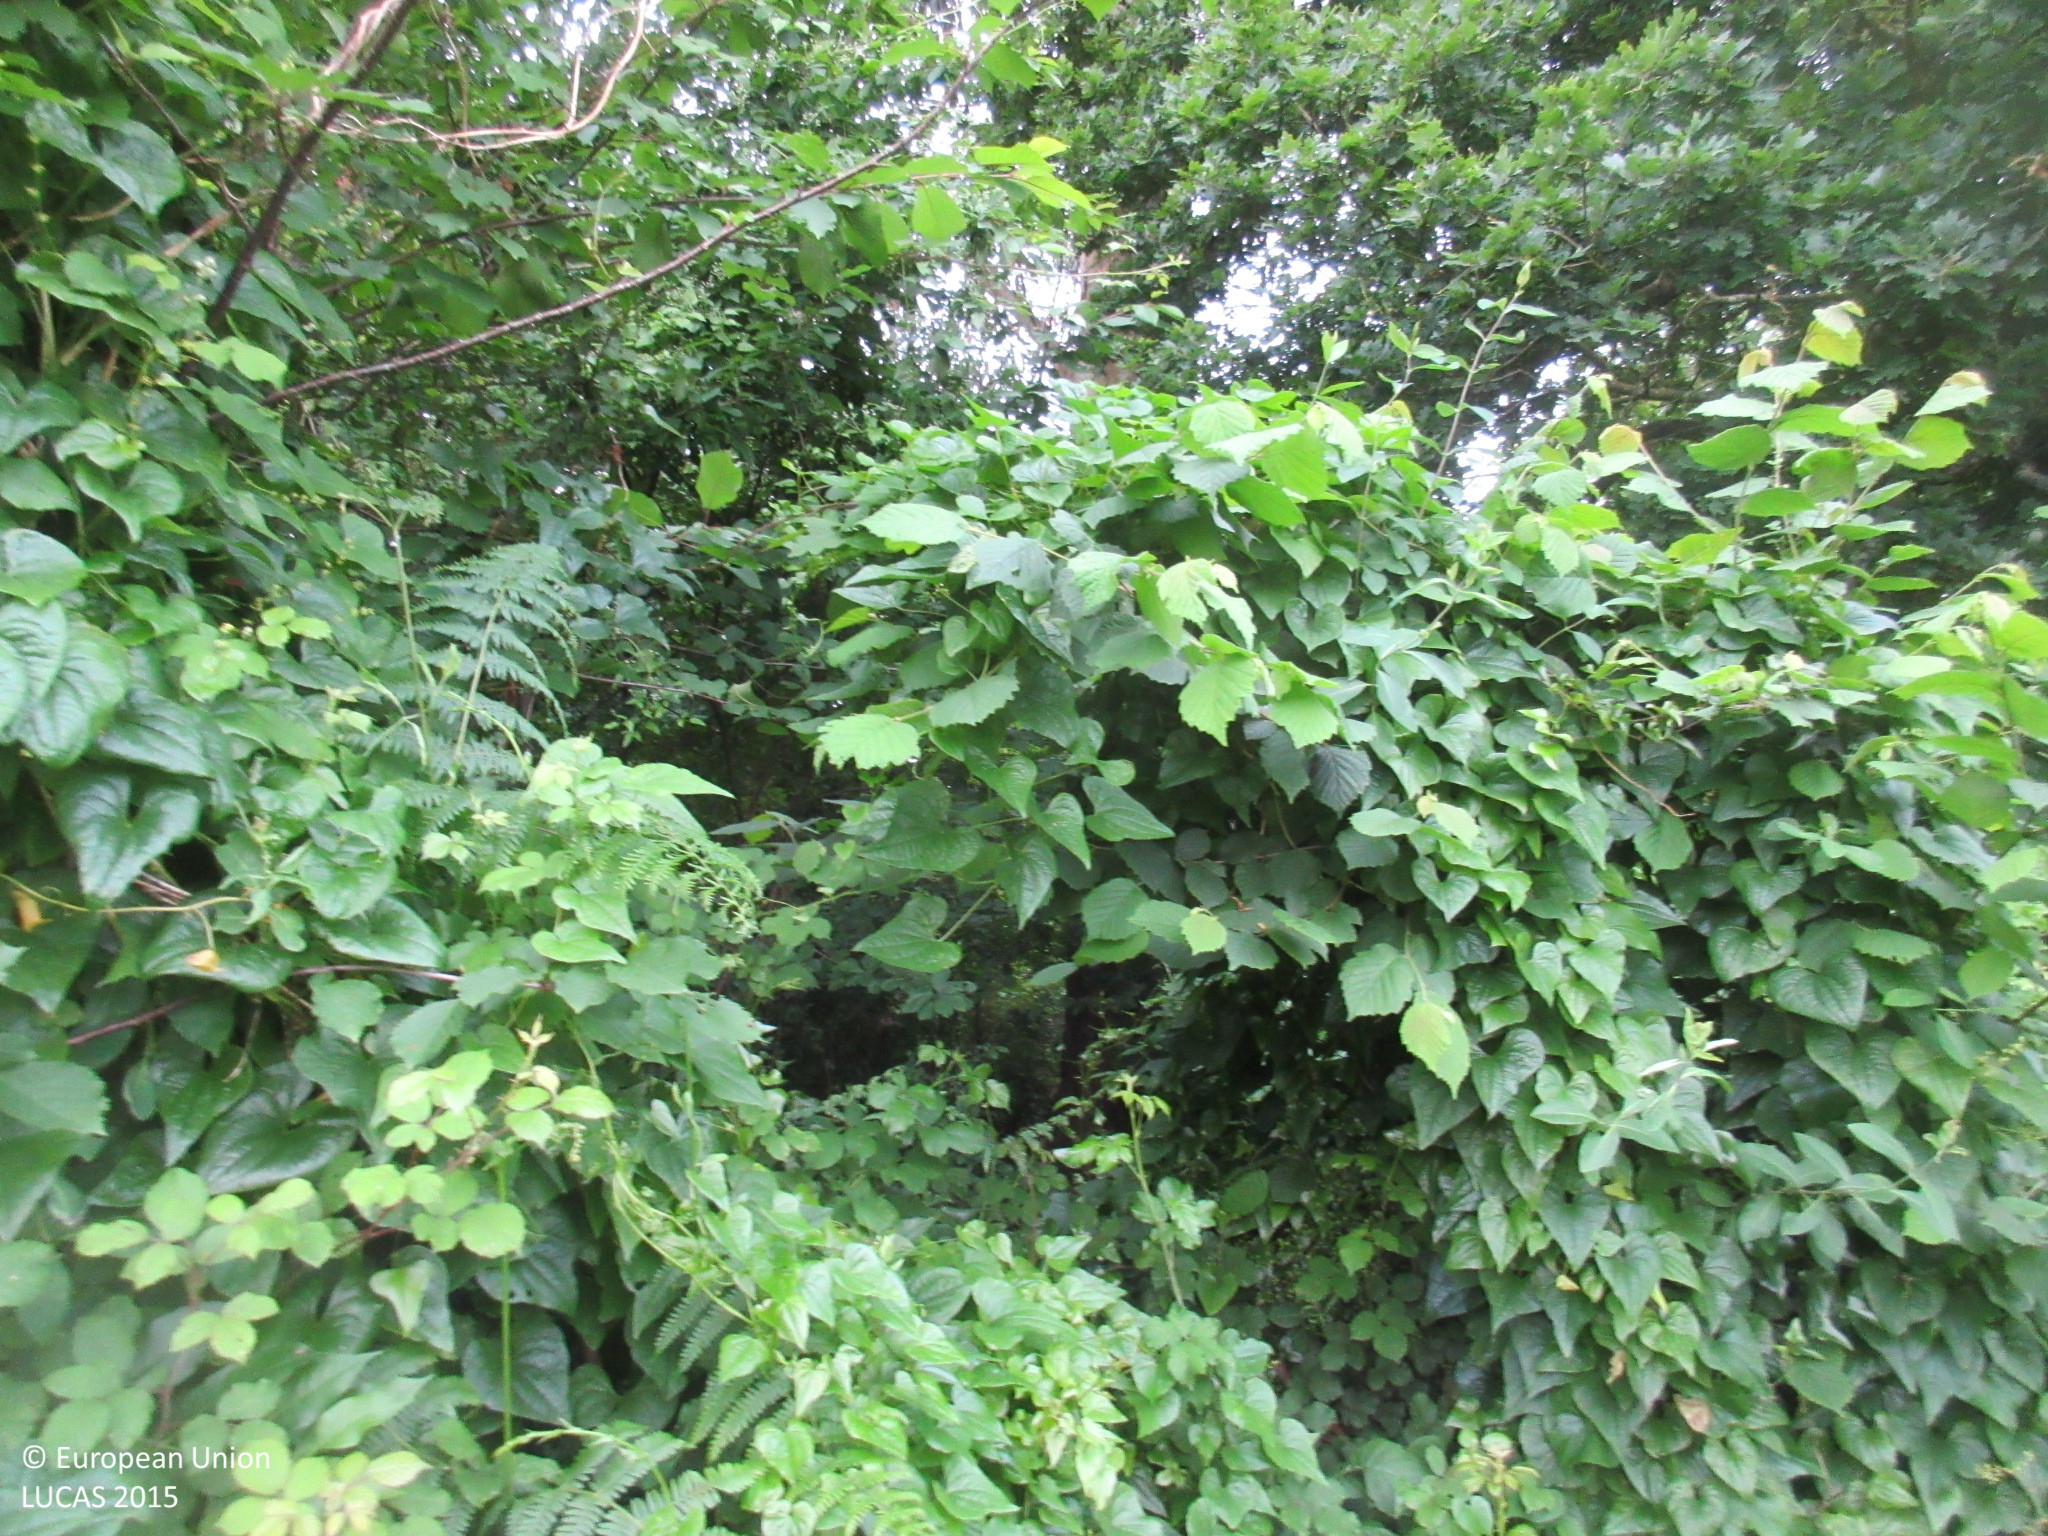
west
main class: Woodland
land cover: Broadleaved woodland
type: thermophilous deciduous forest
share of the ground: > 75 %
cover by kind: broadleaved forest trees 90 %, shrubs 10 %
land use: Semi-natural and natural areas not in use
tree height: > 5 m
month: June
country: ES
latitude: 43.3101
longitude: -3.4185
